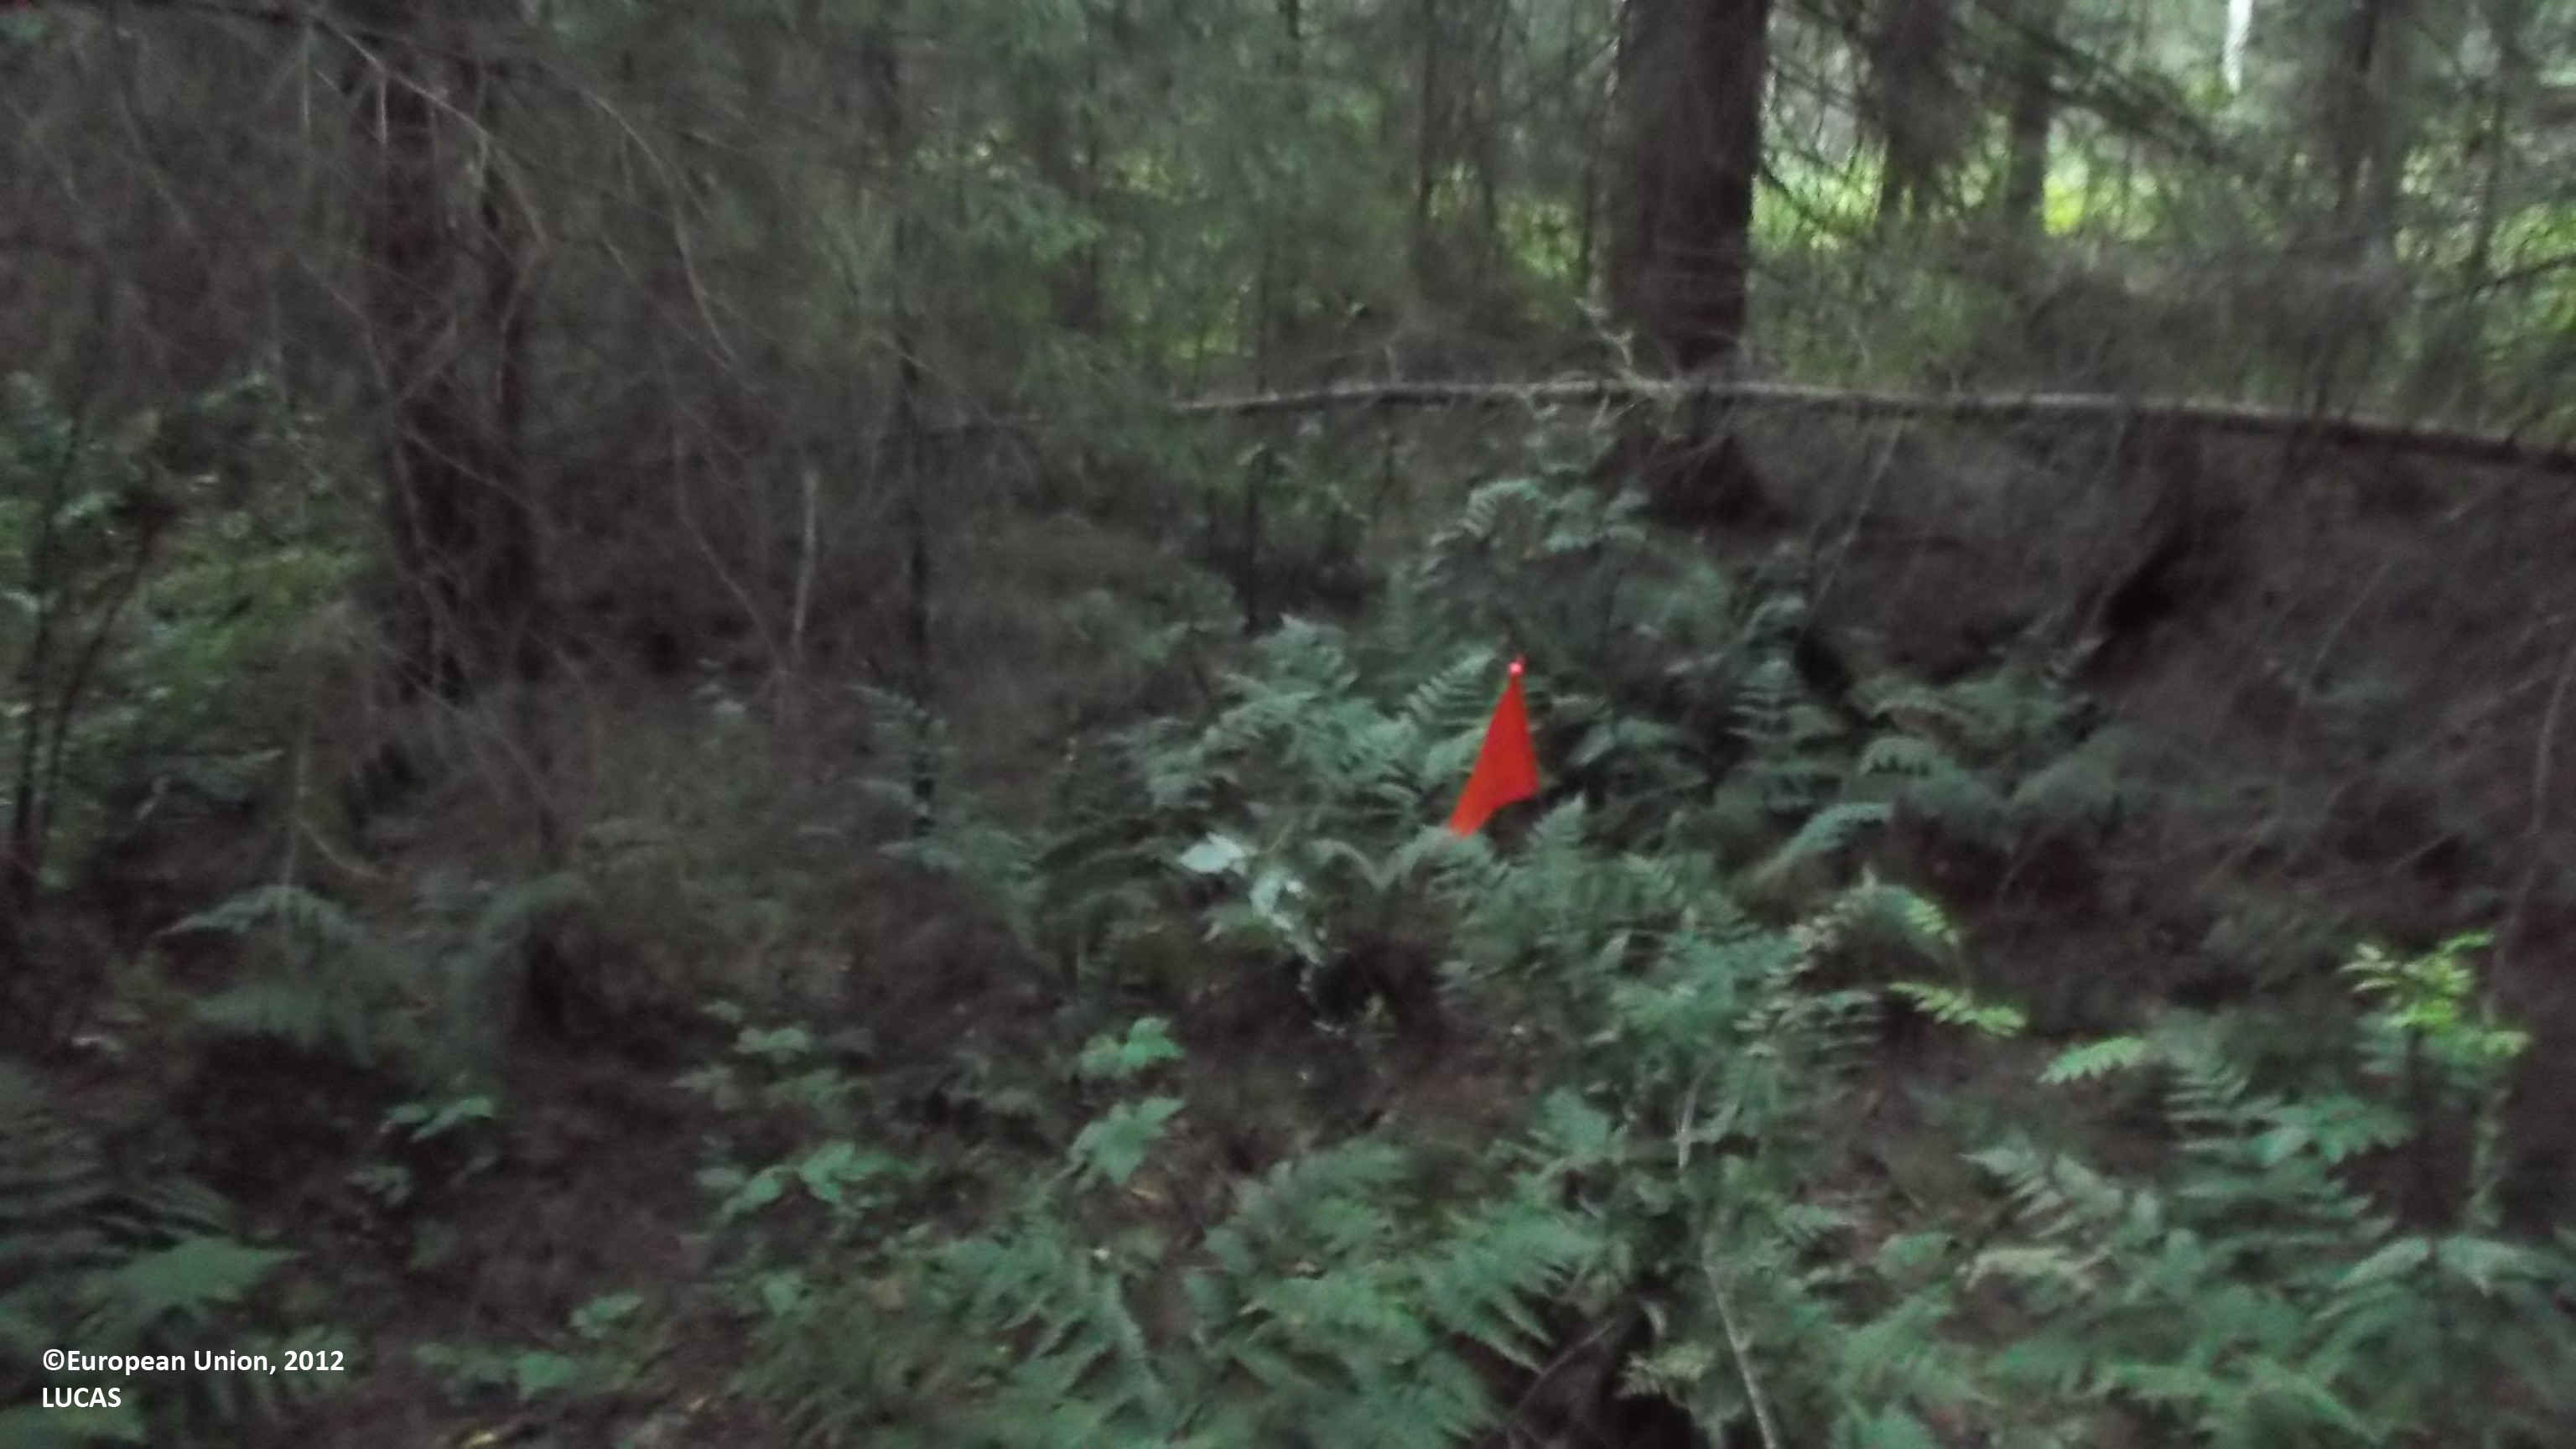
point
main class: Woodland
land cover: Spruce dominated coniferous woodland
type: boreal forest
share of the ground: > 75 %
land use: Forestry
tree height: > 5 m
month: July
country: FI
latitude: 63.6530
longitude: 23.2853
